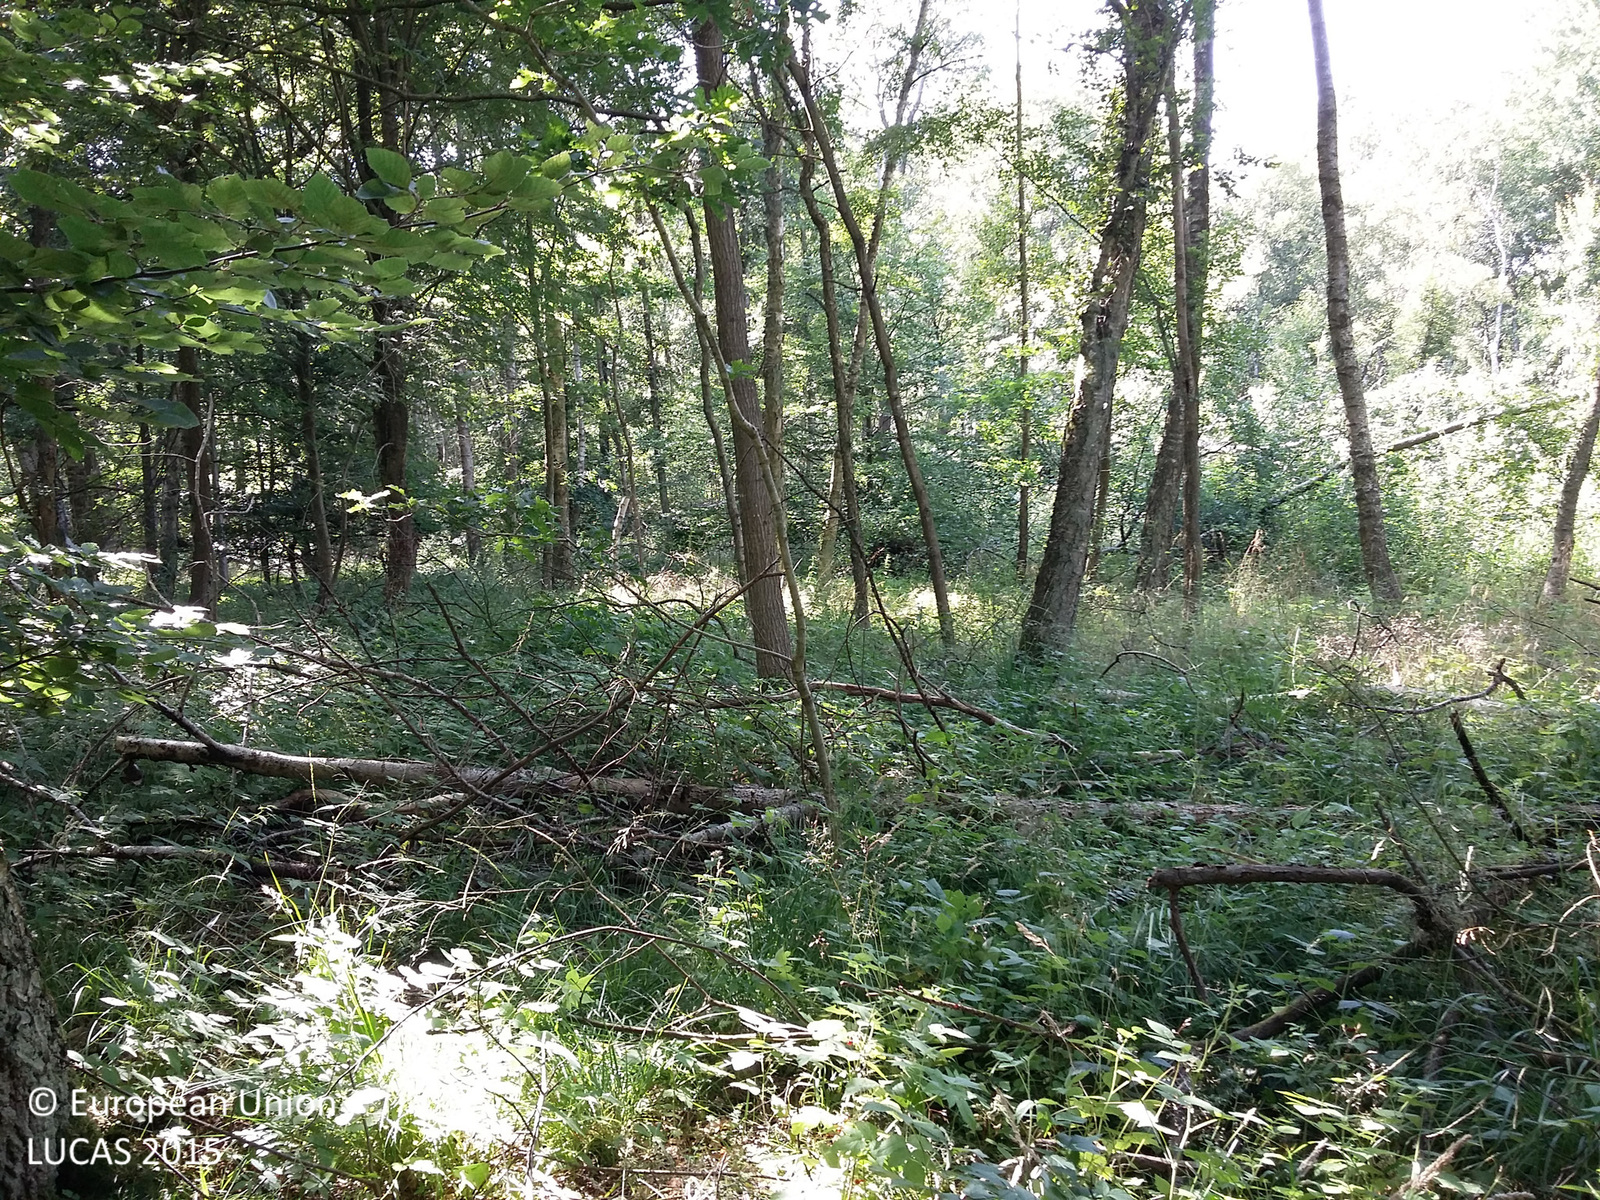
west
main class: Woodland
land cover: Broadleaved woodland
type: acidophilous oak and oak-birch forest
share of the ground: > 75 %
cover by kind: broadleaved forest trees 70 %, herbaceous plants 20 %, shrubs 10 %
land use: Forestry
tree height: > 5 m
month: August
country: DK
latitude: 55.3124
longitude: 11.7790
